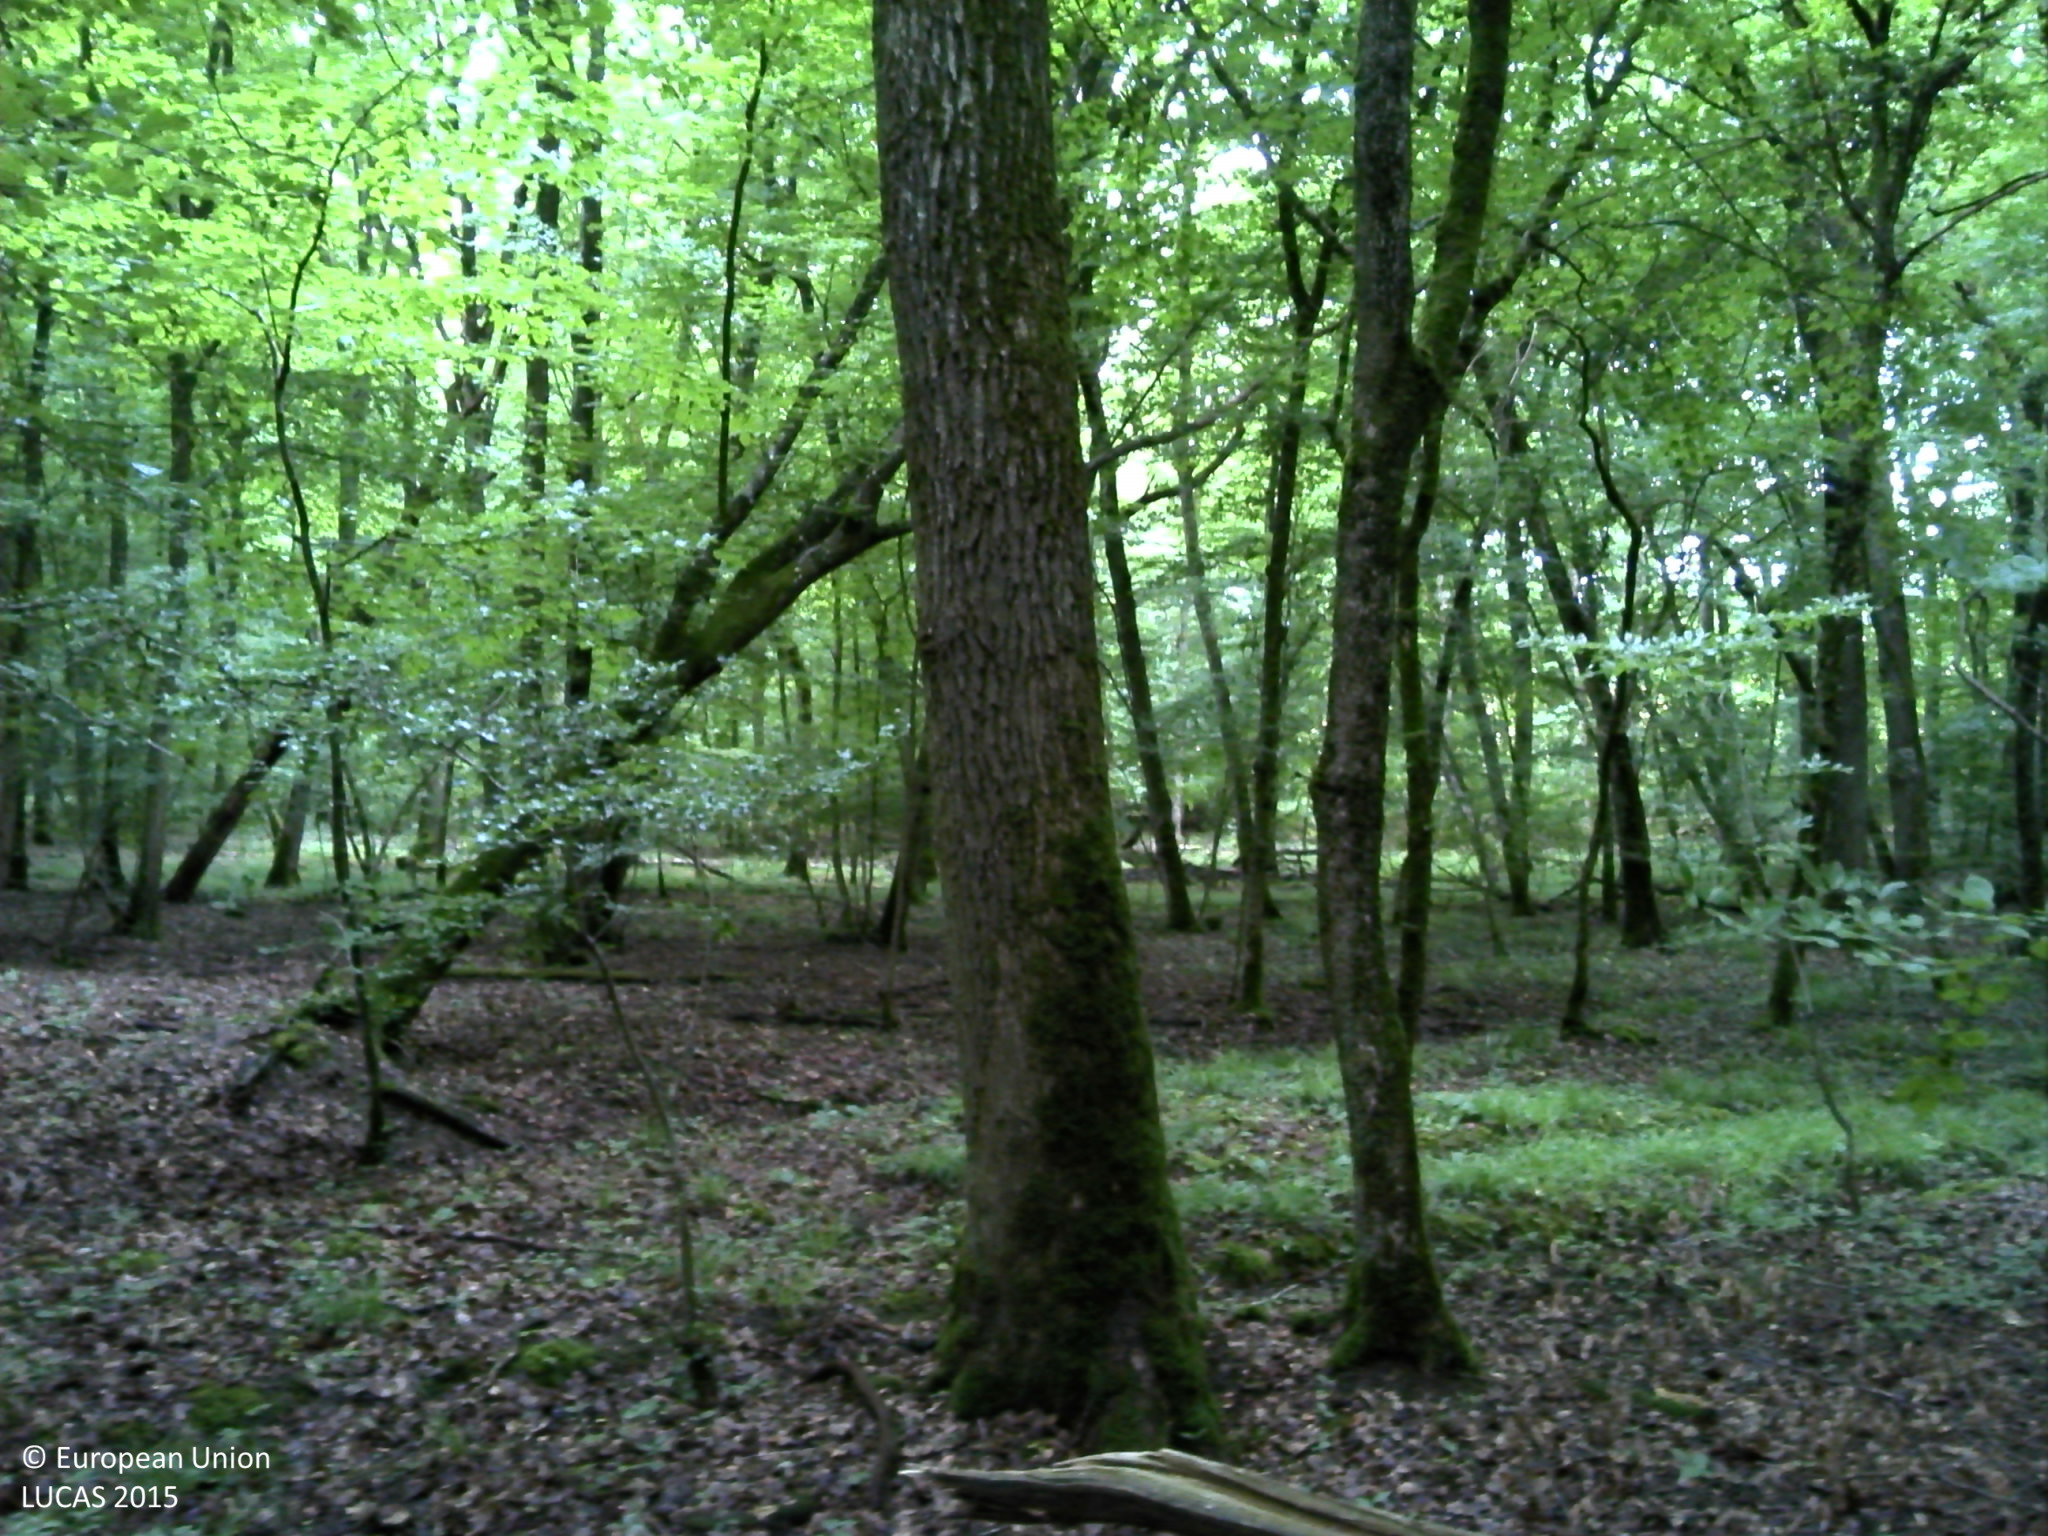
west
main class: Woodland
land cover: Broadleaved woodland
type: acidophilous oak and oak-birch forest
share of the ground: > 75 %
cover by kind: broadleaved forest trees 100 %
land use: Forestry
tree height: > 5 m
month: June
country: FR
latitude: 49.0131
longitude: 6.4589
